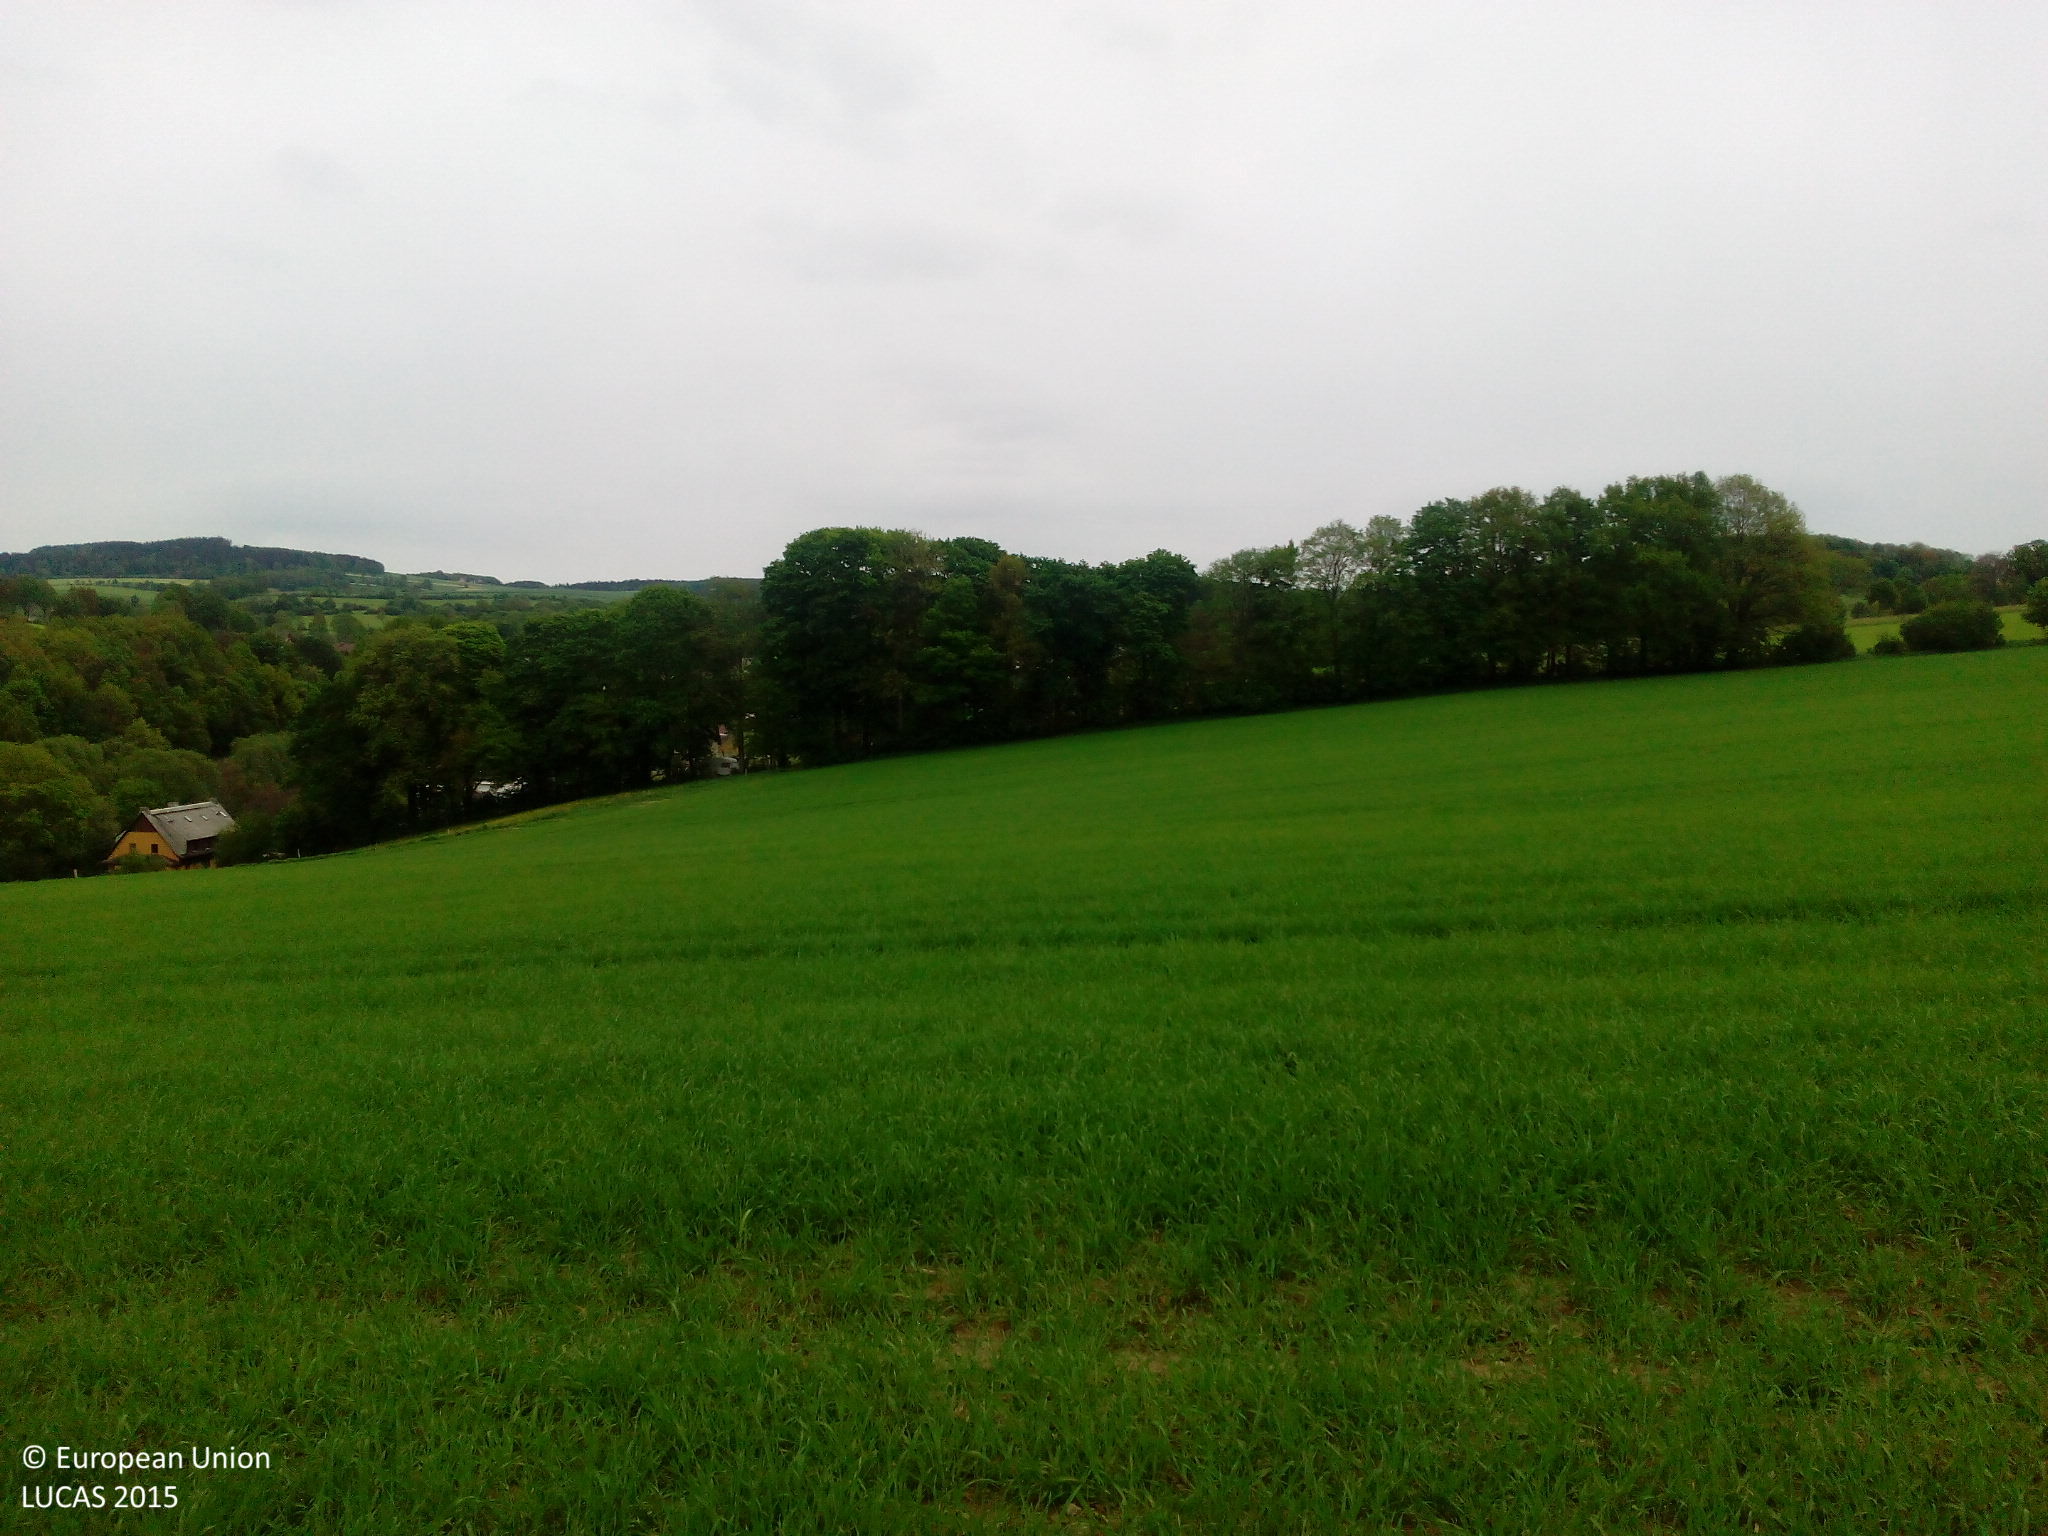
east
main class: Cropland
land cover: Barley
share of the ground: > 75 %
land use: Agriculture (excluding fallow land and kitchen gardens)
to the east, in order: Barley; Broadleaved woodland; Tracks; Fences; Grassland without tree/shrub cover
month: May
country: DE
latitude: 50.6827
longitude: 13.0713
